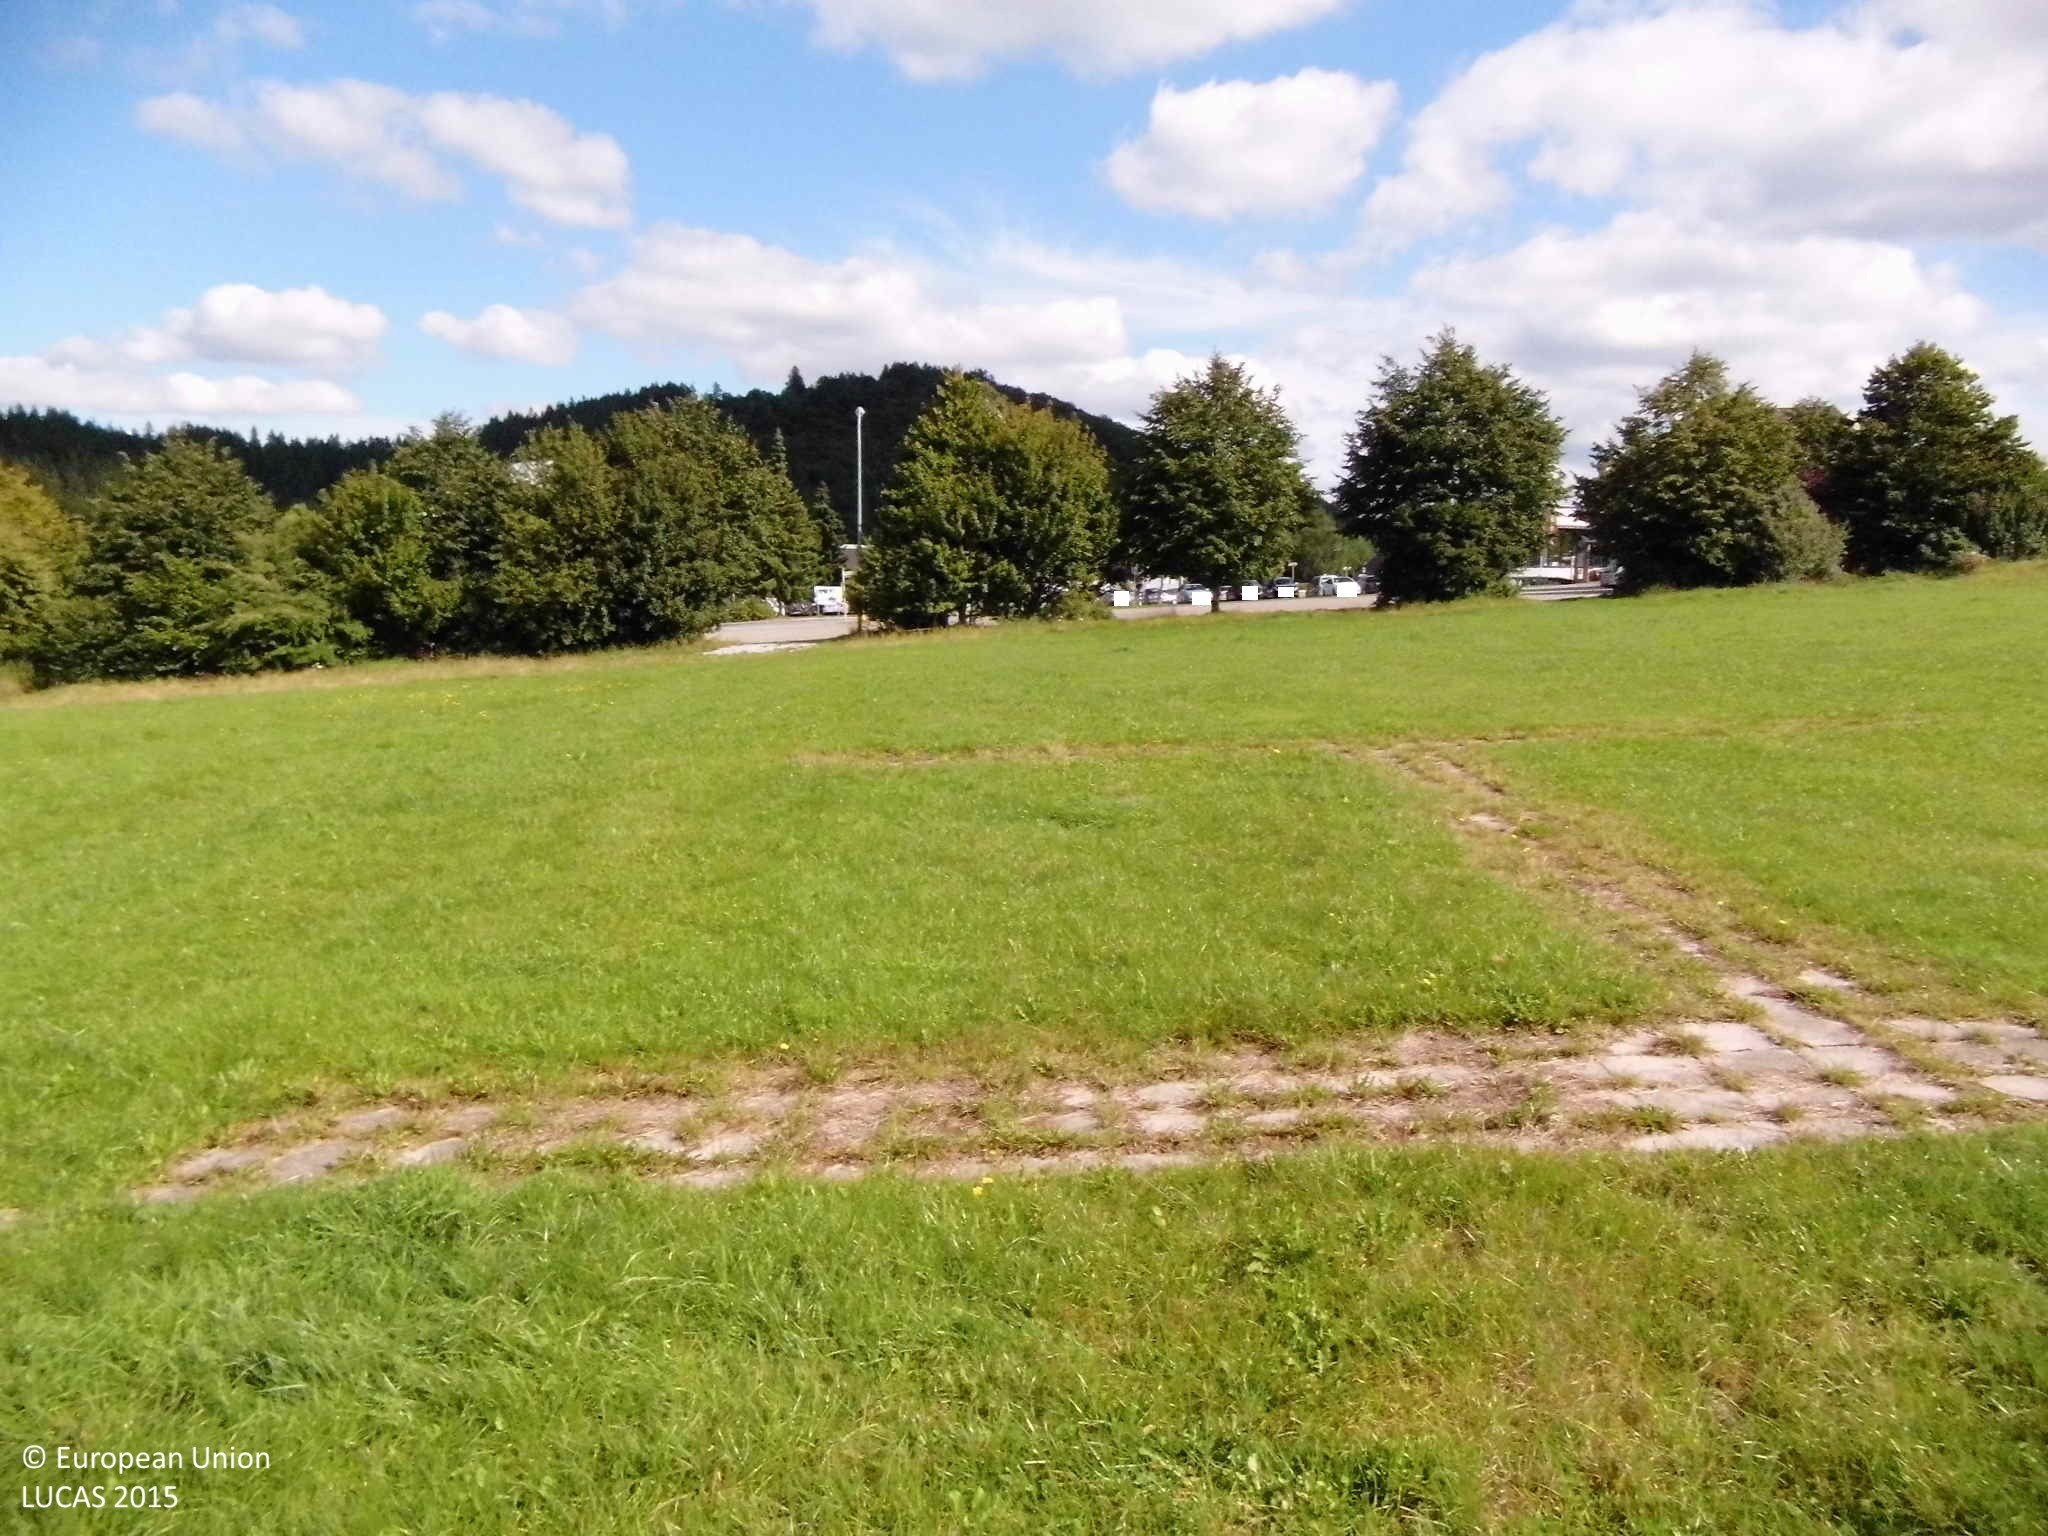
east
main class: Grassland
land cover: Grassland without tree/shrub cover
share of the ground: > 75 %
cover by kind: herbaceous plants 100 %
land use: Air transport
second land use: Agriculture (excluding fallow land and kitchen gardens)
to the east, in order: Grassland without tree/shrub cover; Lines of trees; Artificial constructions in urban areas
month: September
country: DE
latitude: 51.2906
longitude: 8.6094
